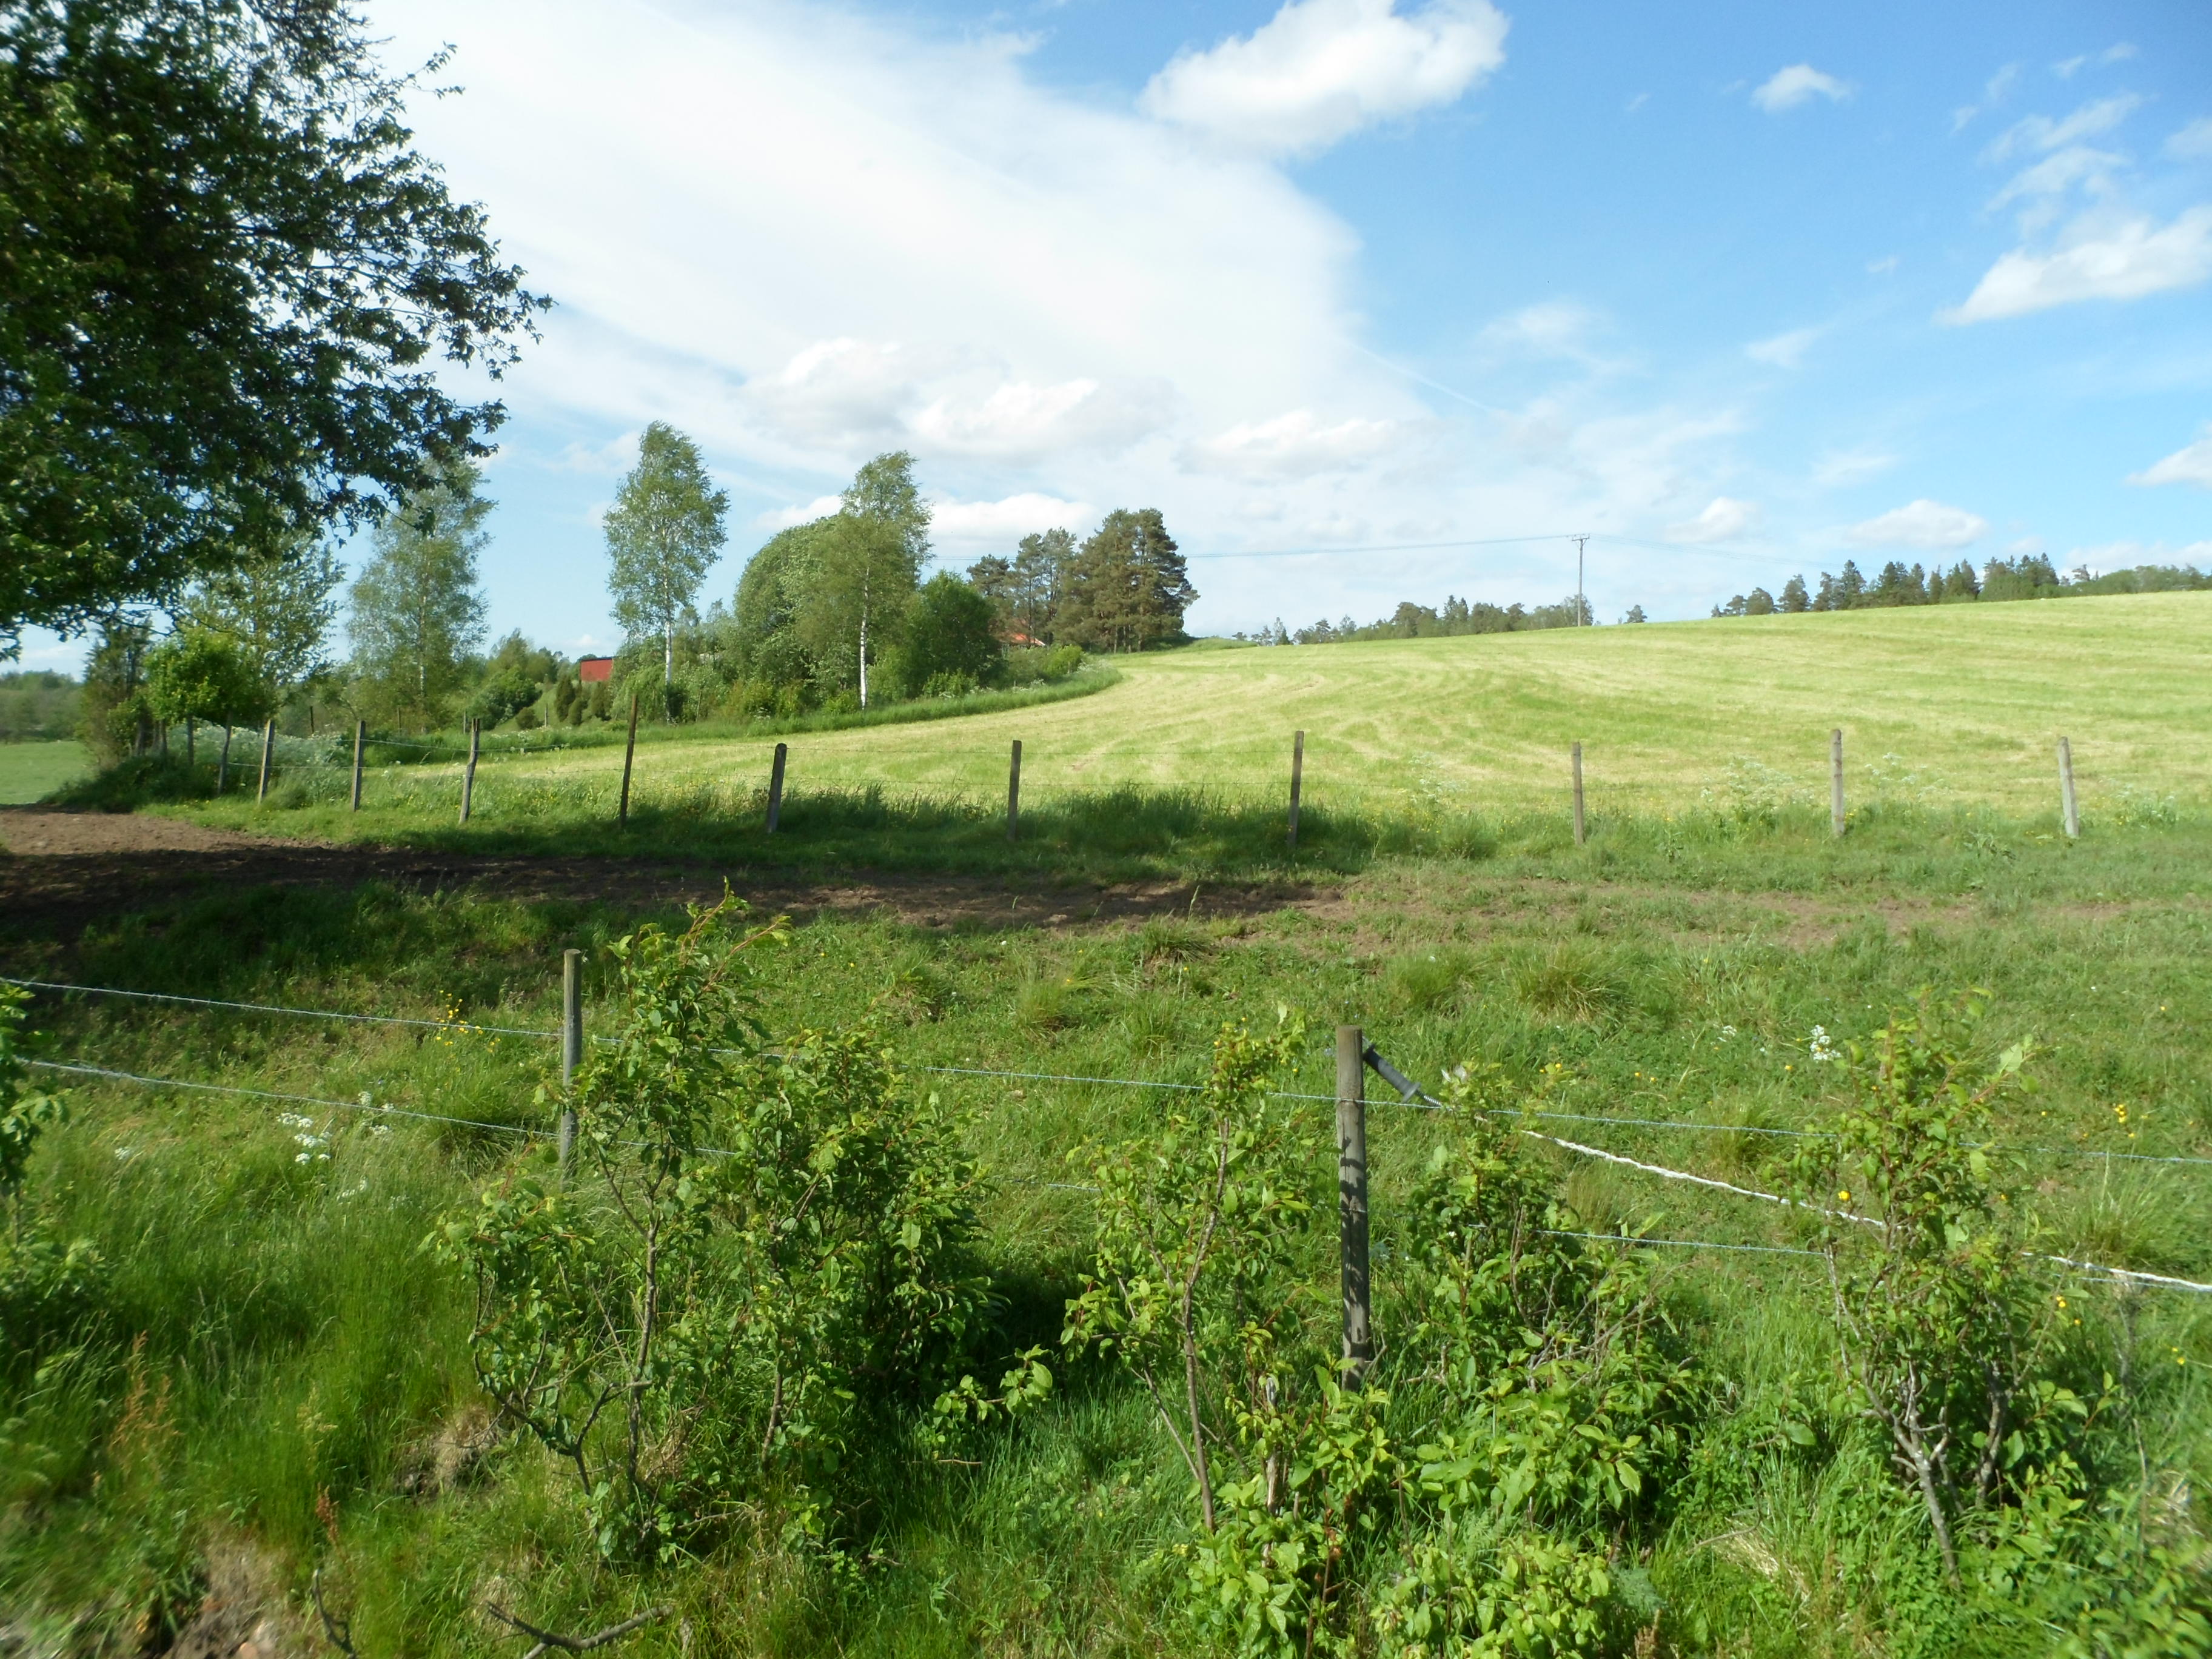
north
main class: Cropland
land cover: Barley
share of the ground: > 75 %
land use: Agriculture (excluding fallow land and kitchen gardens)
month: June
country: SE
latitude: 57.4659
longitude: 14.3136
